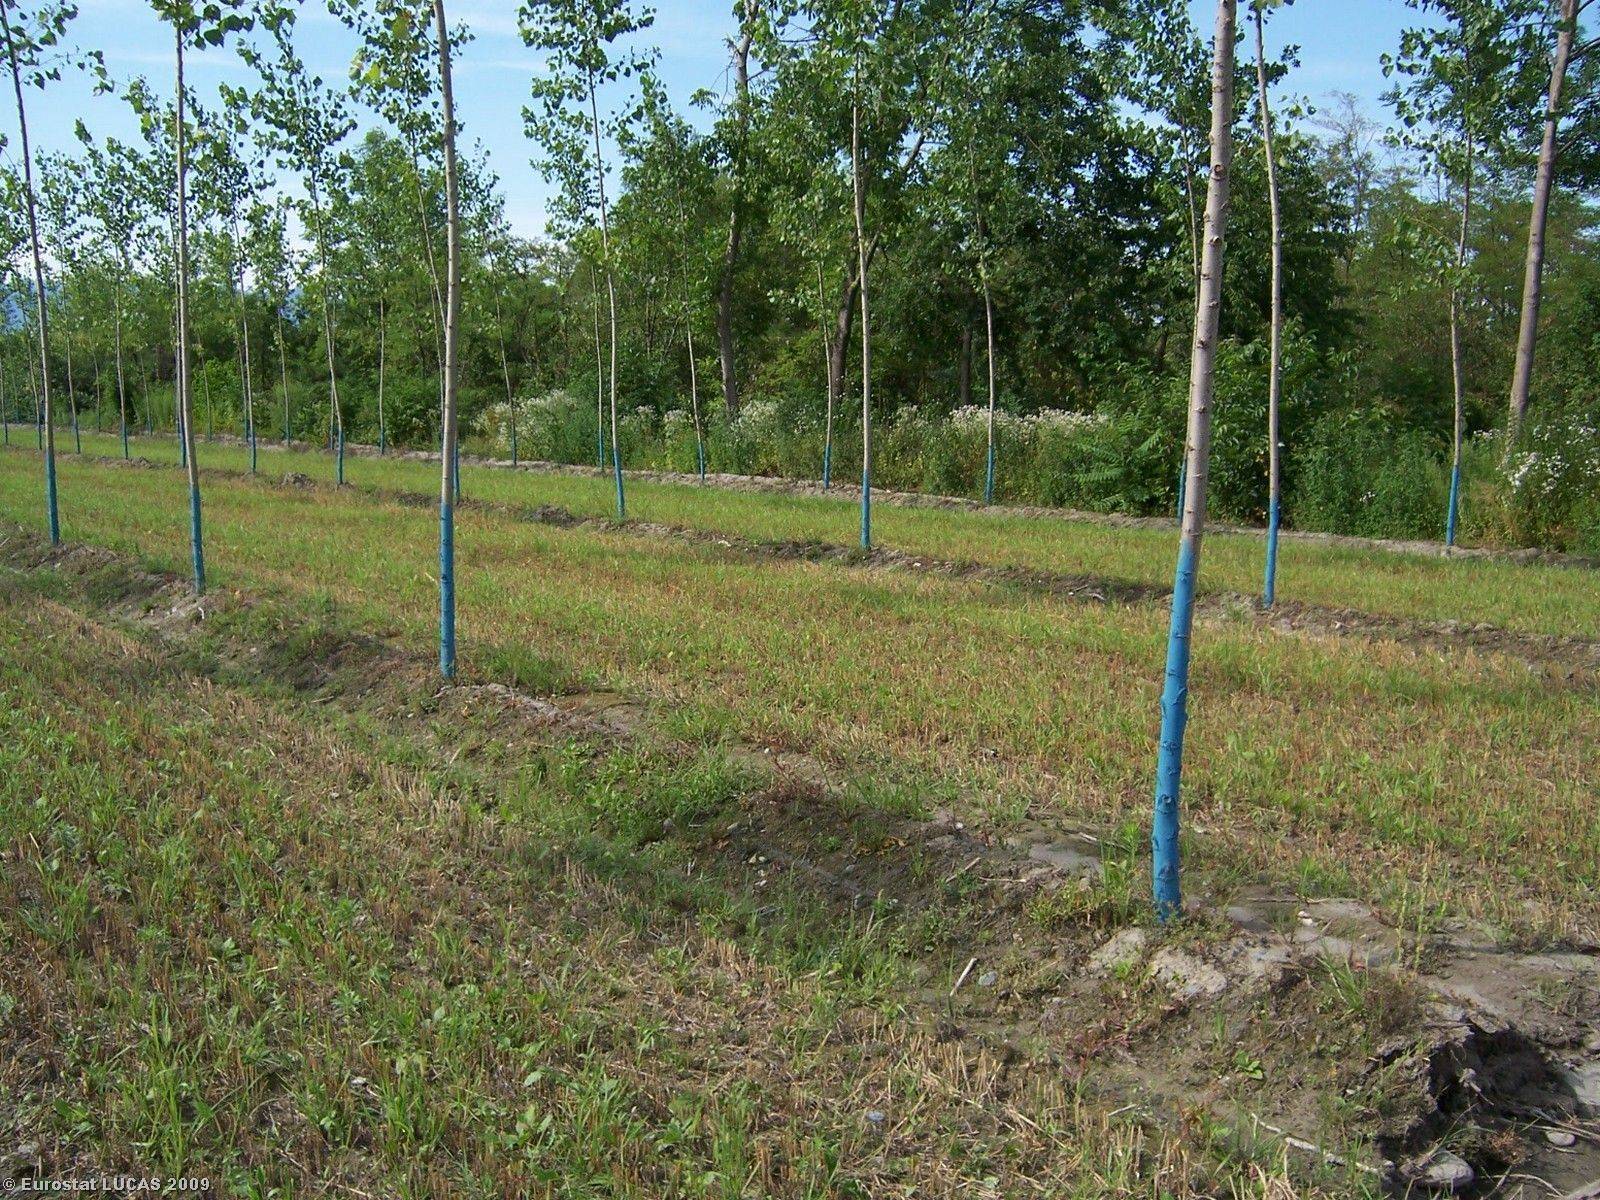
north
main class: Woodland
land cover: Broadleaved woodland
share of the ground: 25 - 50 %
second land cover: Barley
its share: > 75 %
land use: Forestry
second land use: Agriculture (excluding fallow land and kitchen gardens)
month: July
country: IT
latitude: 44.8409
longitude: 7.3860
